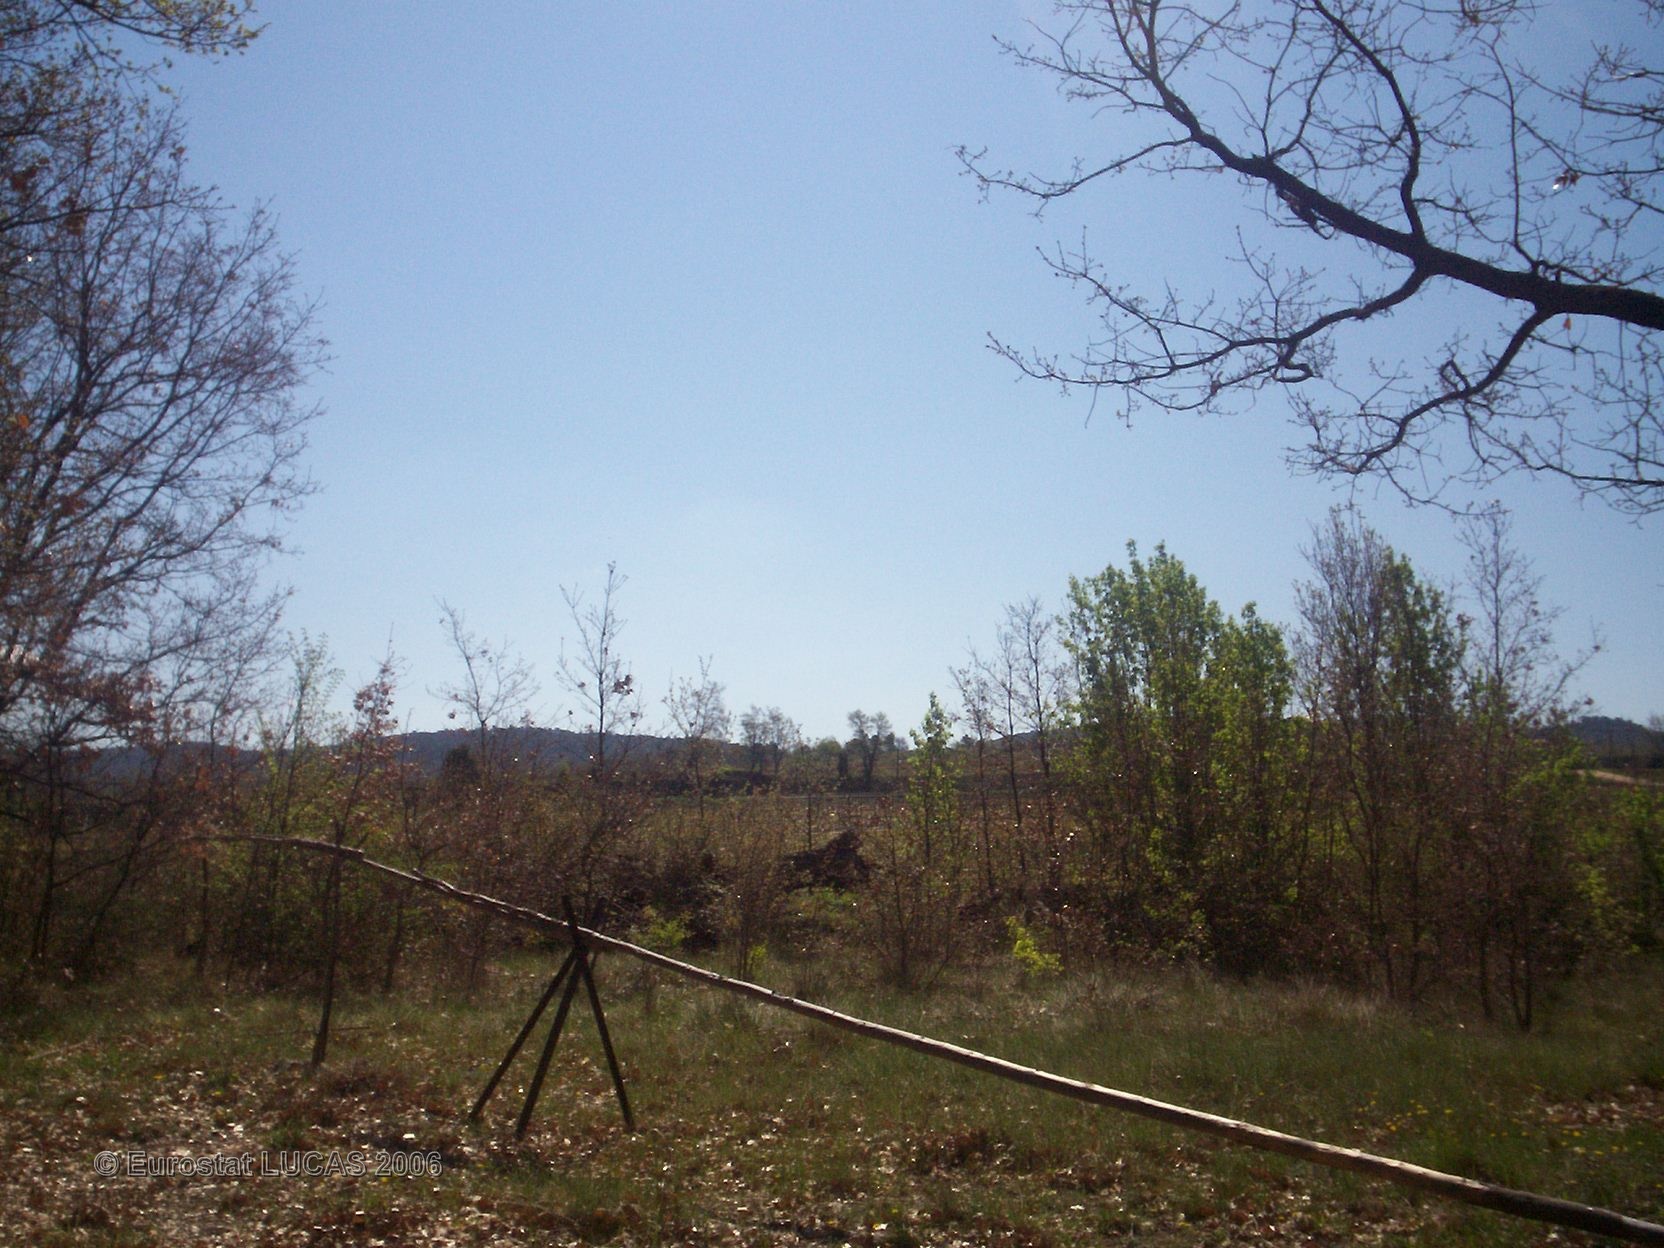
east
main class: Woodland
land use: Forestry
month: April
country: FR
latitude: 43.8475
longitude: 5.3193
